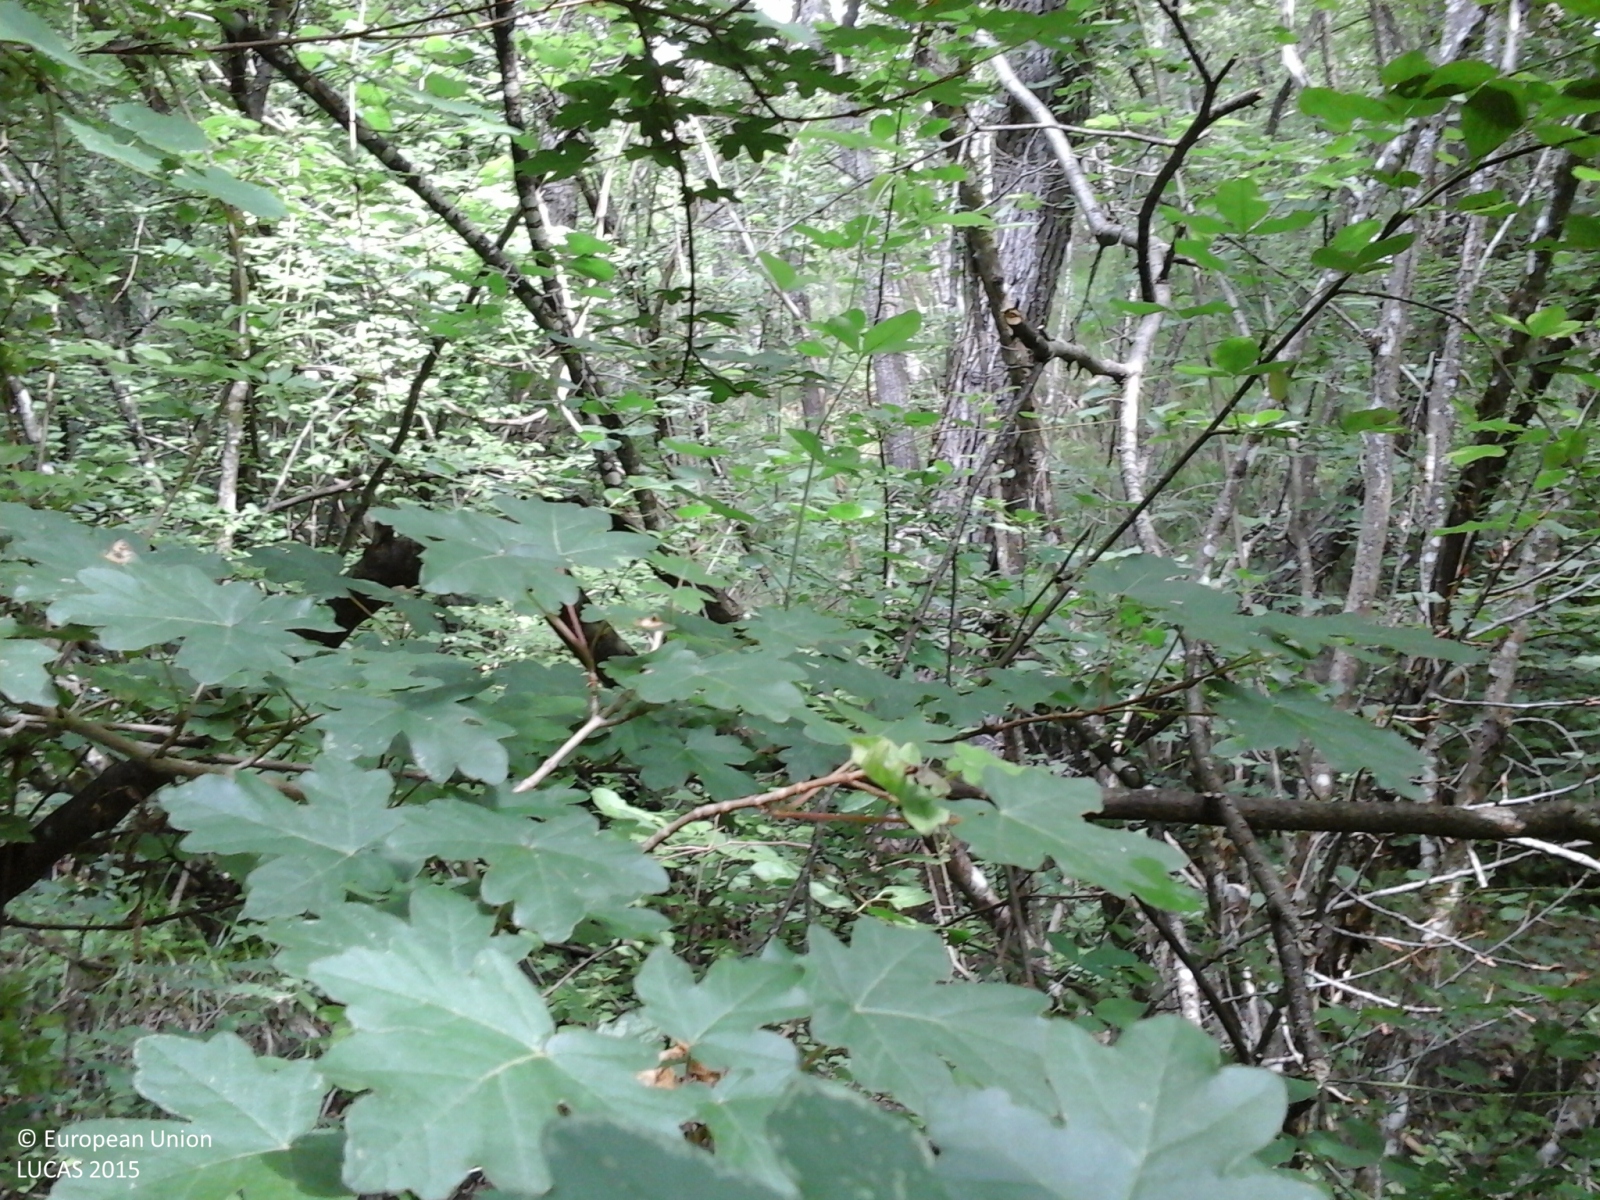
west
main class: Woodland
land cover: Broadleaved woodland
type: thermophilous deciduous forest
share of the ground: > 75 %
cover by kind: broadleaved forest trees 95 %, shrubs 5 %
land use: Forestry
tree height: > 5 m
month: June
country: IT
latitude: 44.7828
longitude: 9.6595
